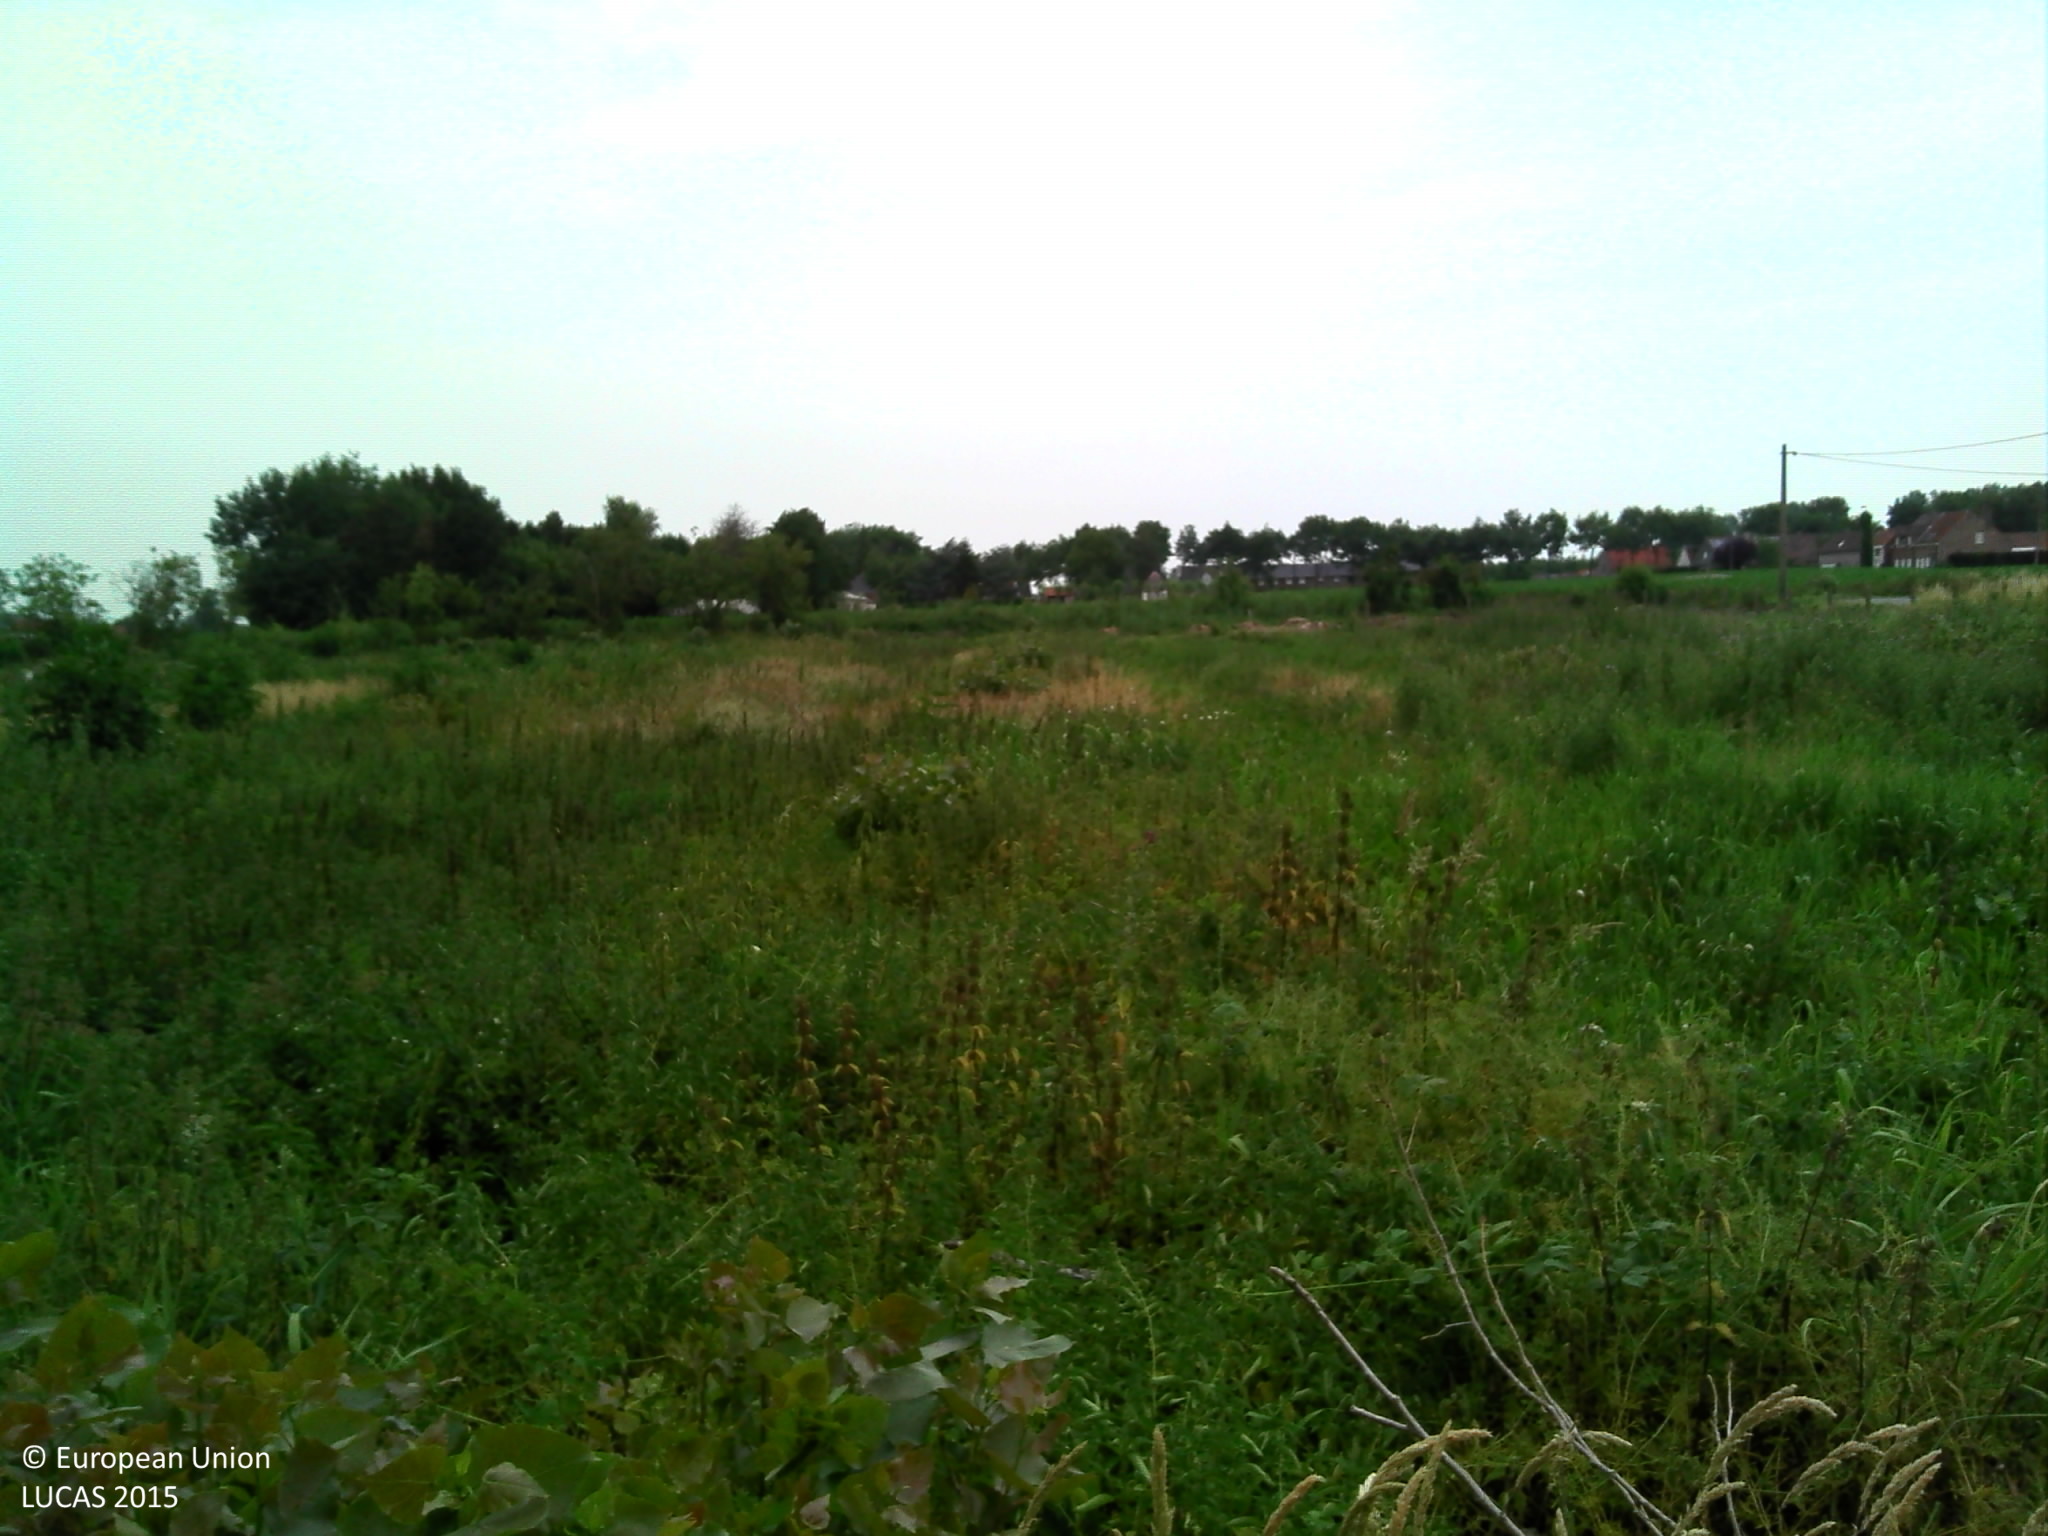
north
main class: Grassland
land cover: Spontaneously vegetated surfaces
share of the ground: > 75 %
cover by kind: herbaceous plants 100 %
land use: Forestry
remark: Clear cut
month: July
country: BE
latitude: 51.2126
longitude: 3.5936
